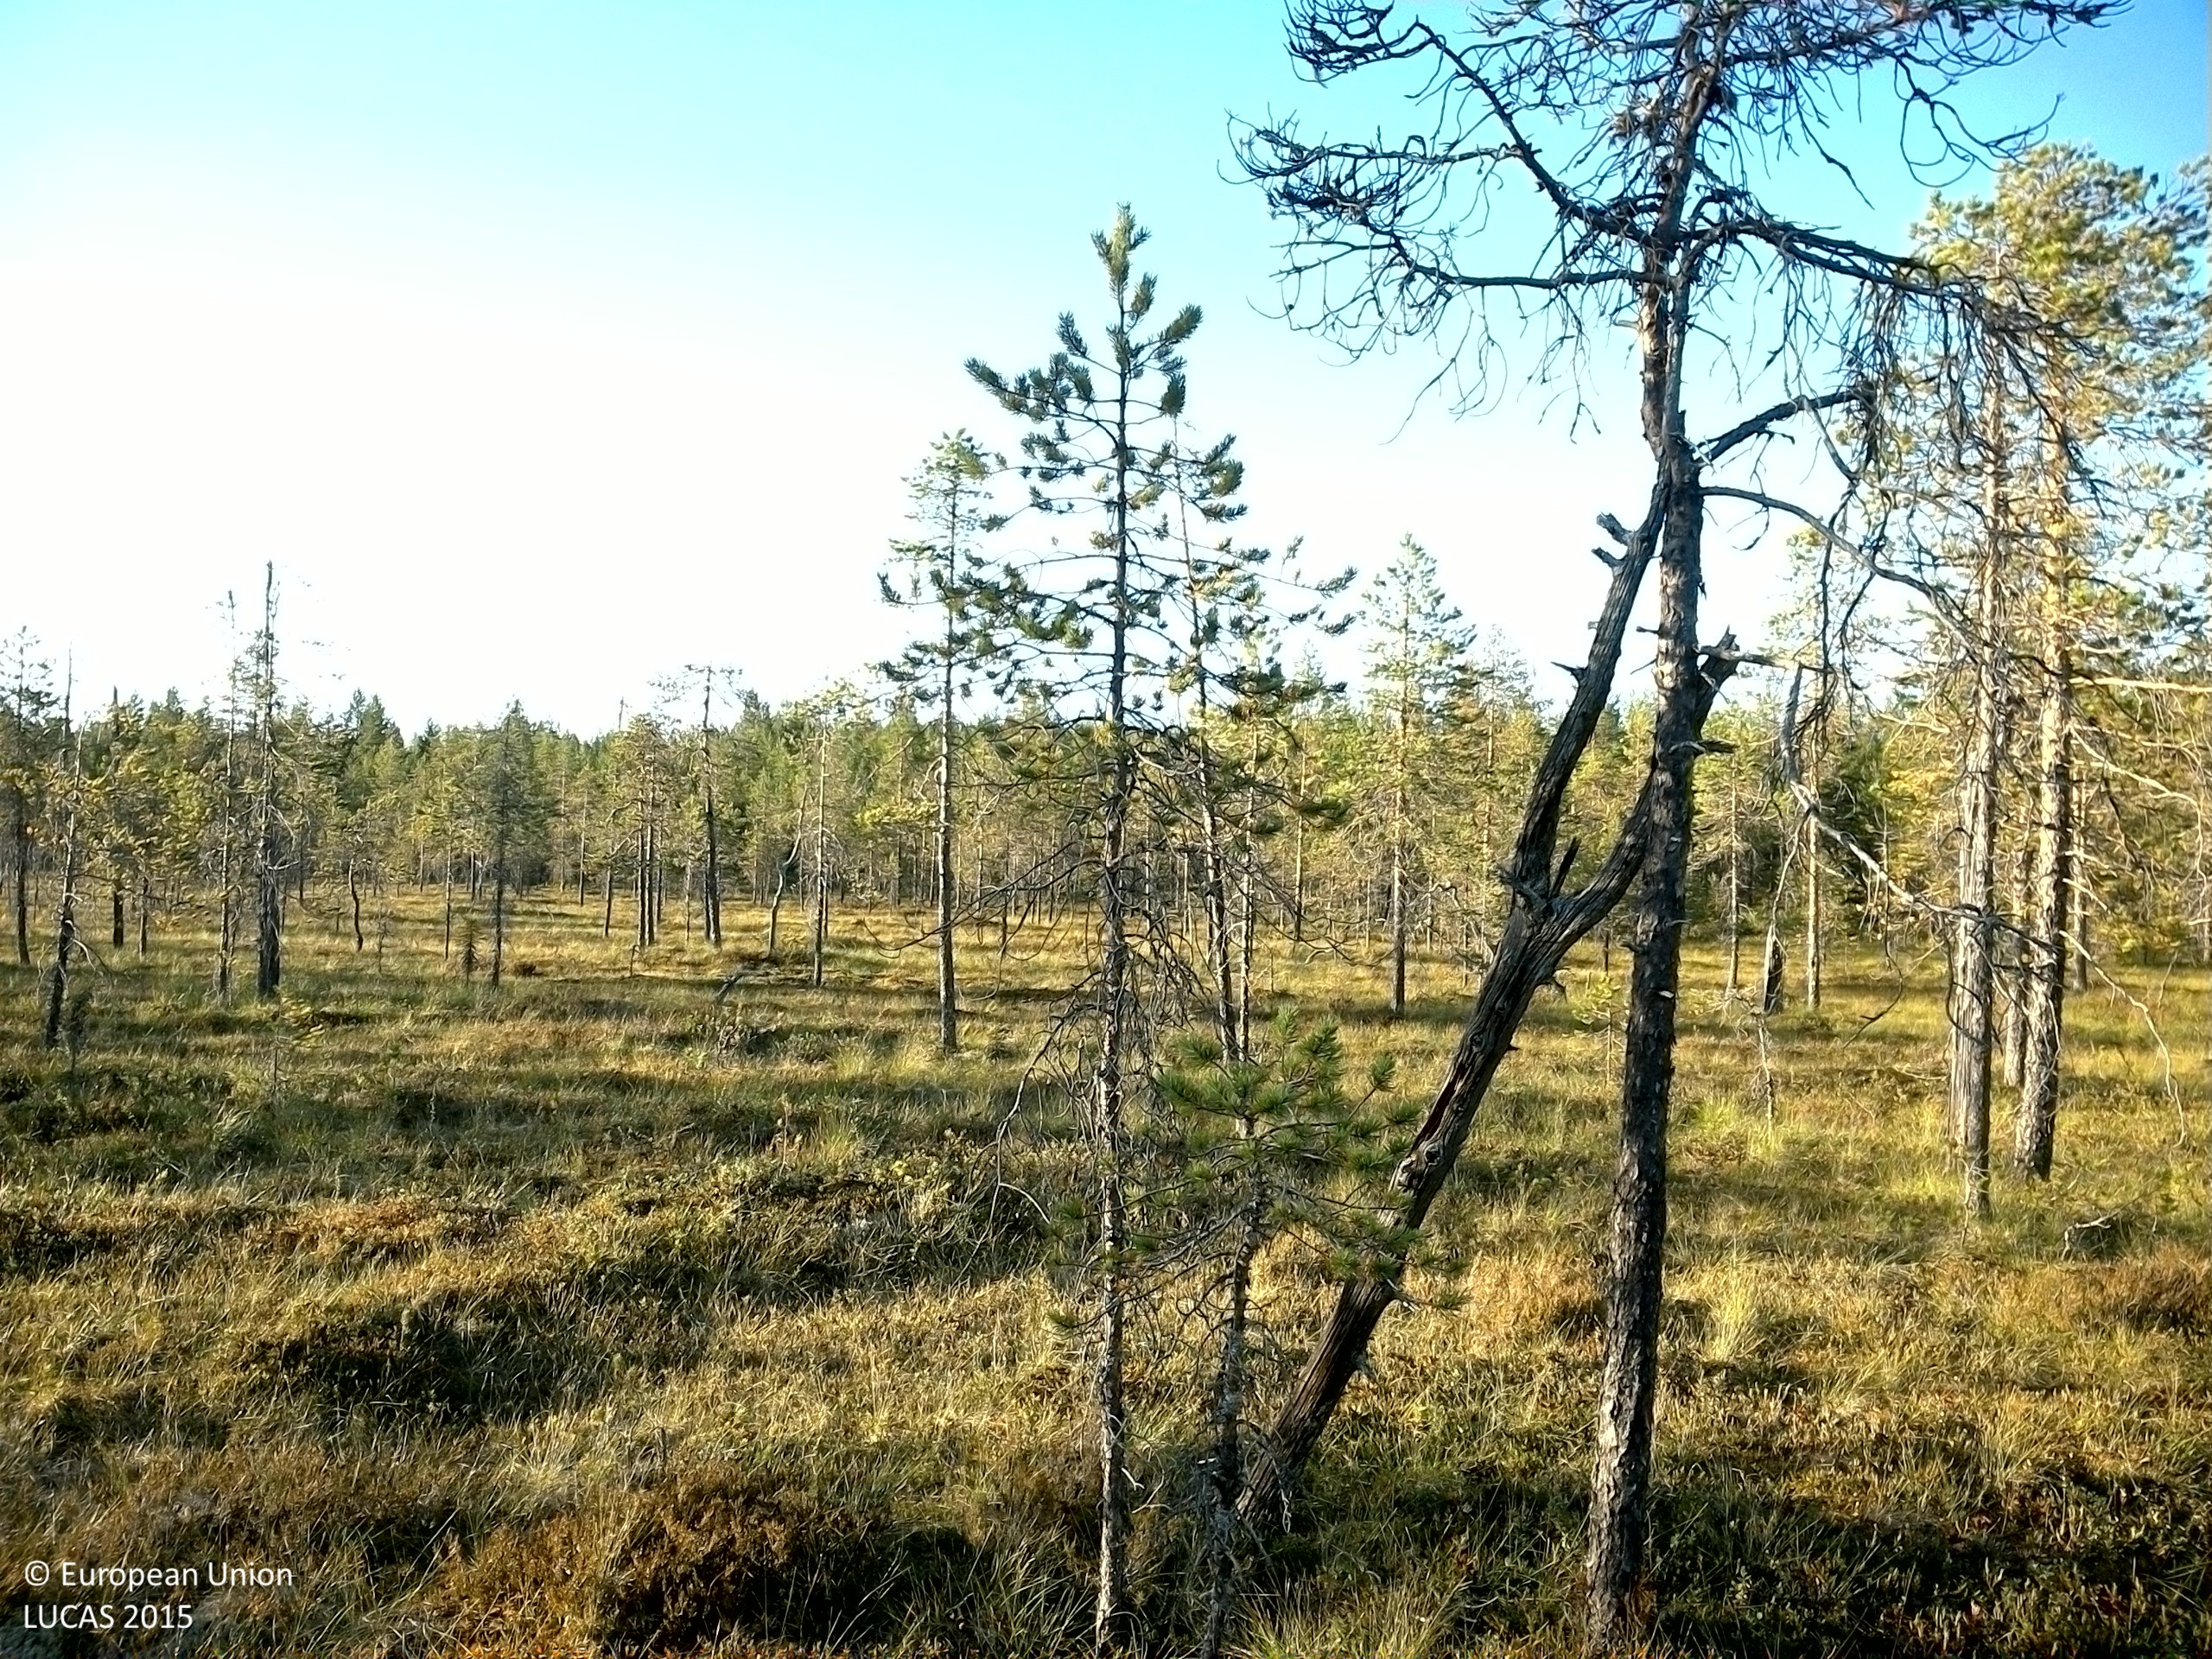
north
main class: Woodland
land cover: Pine dominated coniferous woodland
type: boreal forest
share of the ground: 10 - 25 %
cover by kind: shrubs 50 %, lichens and mosses 25 %, coniferous forest trees 15 %, herbaceous plants 10 %
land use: Semi-natural and natural areas not in use
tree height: < 5 m
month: August
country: SE
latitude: 63.6857
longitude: 18.0410
